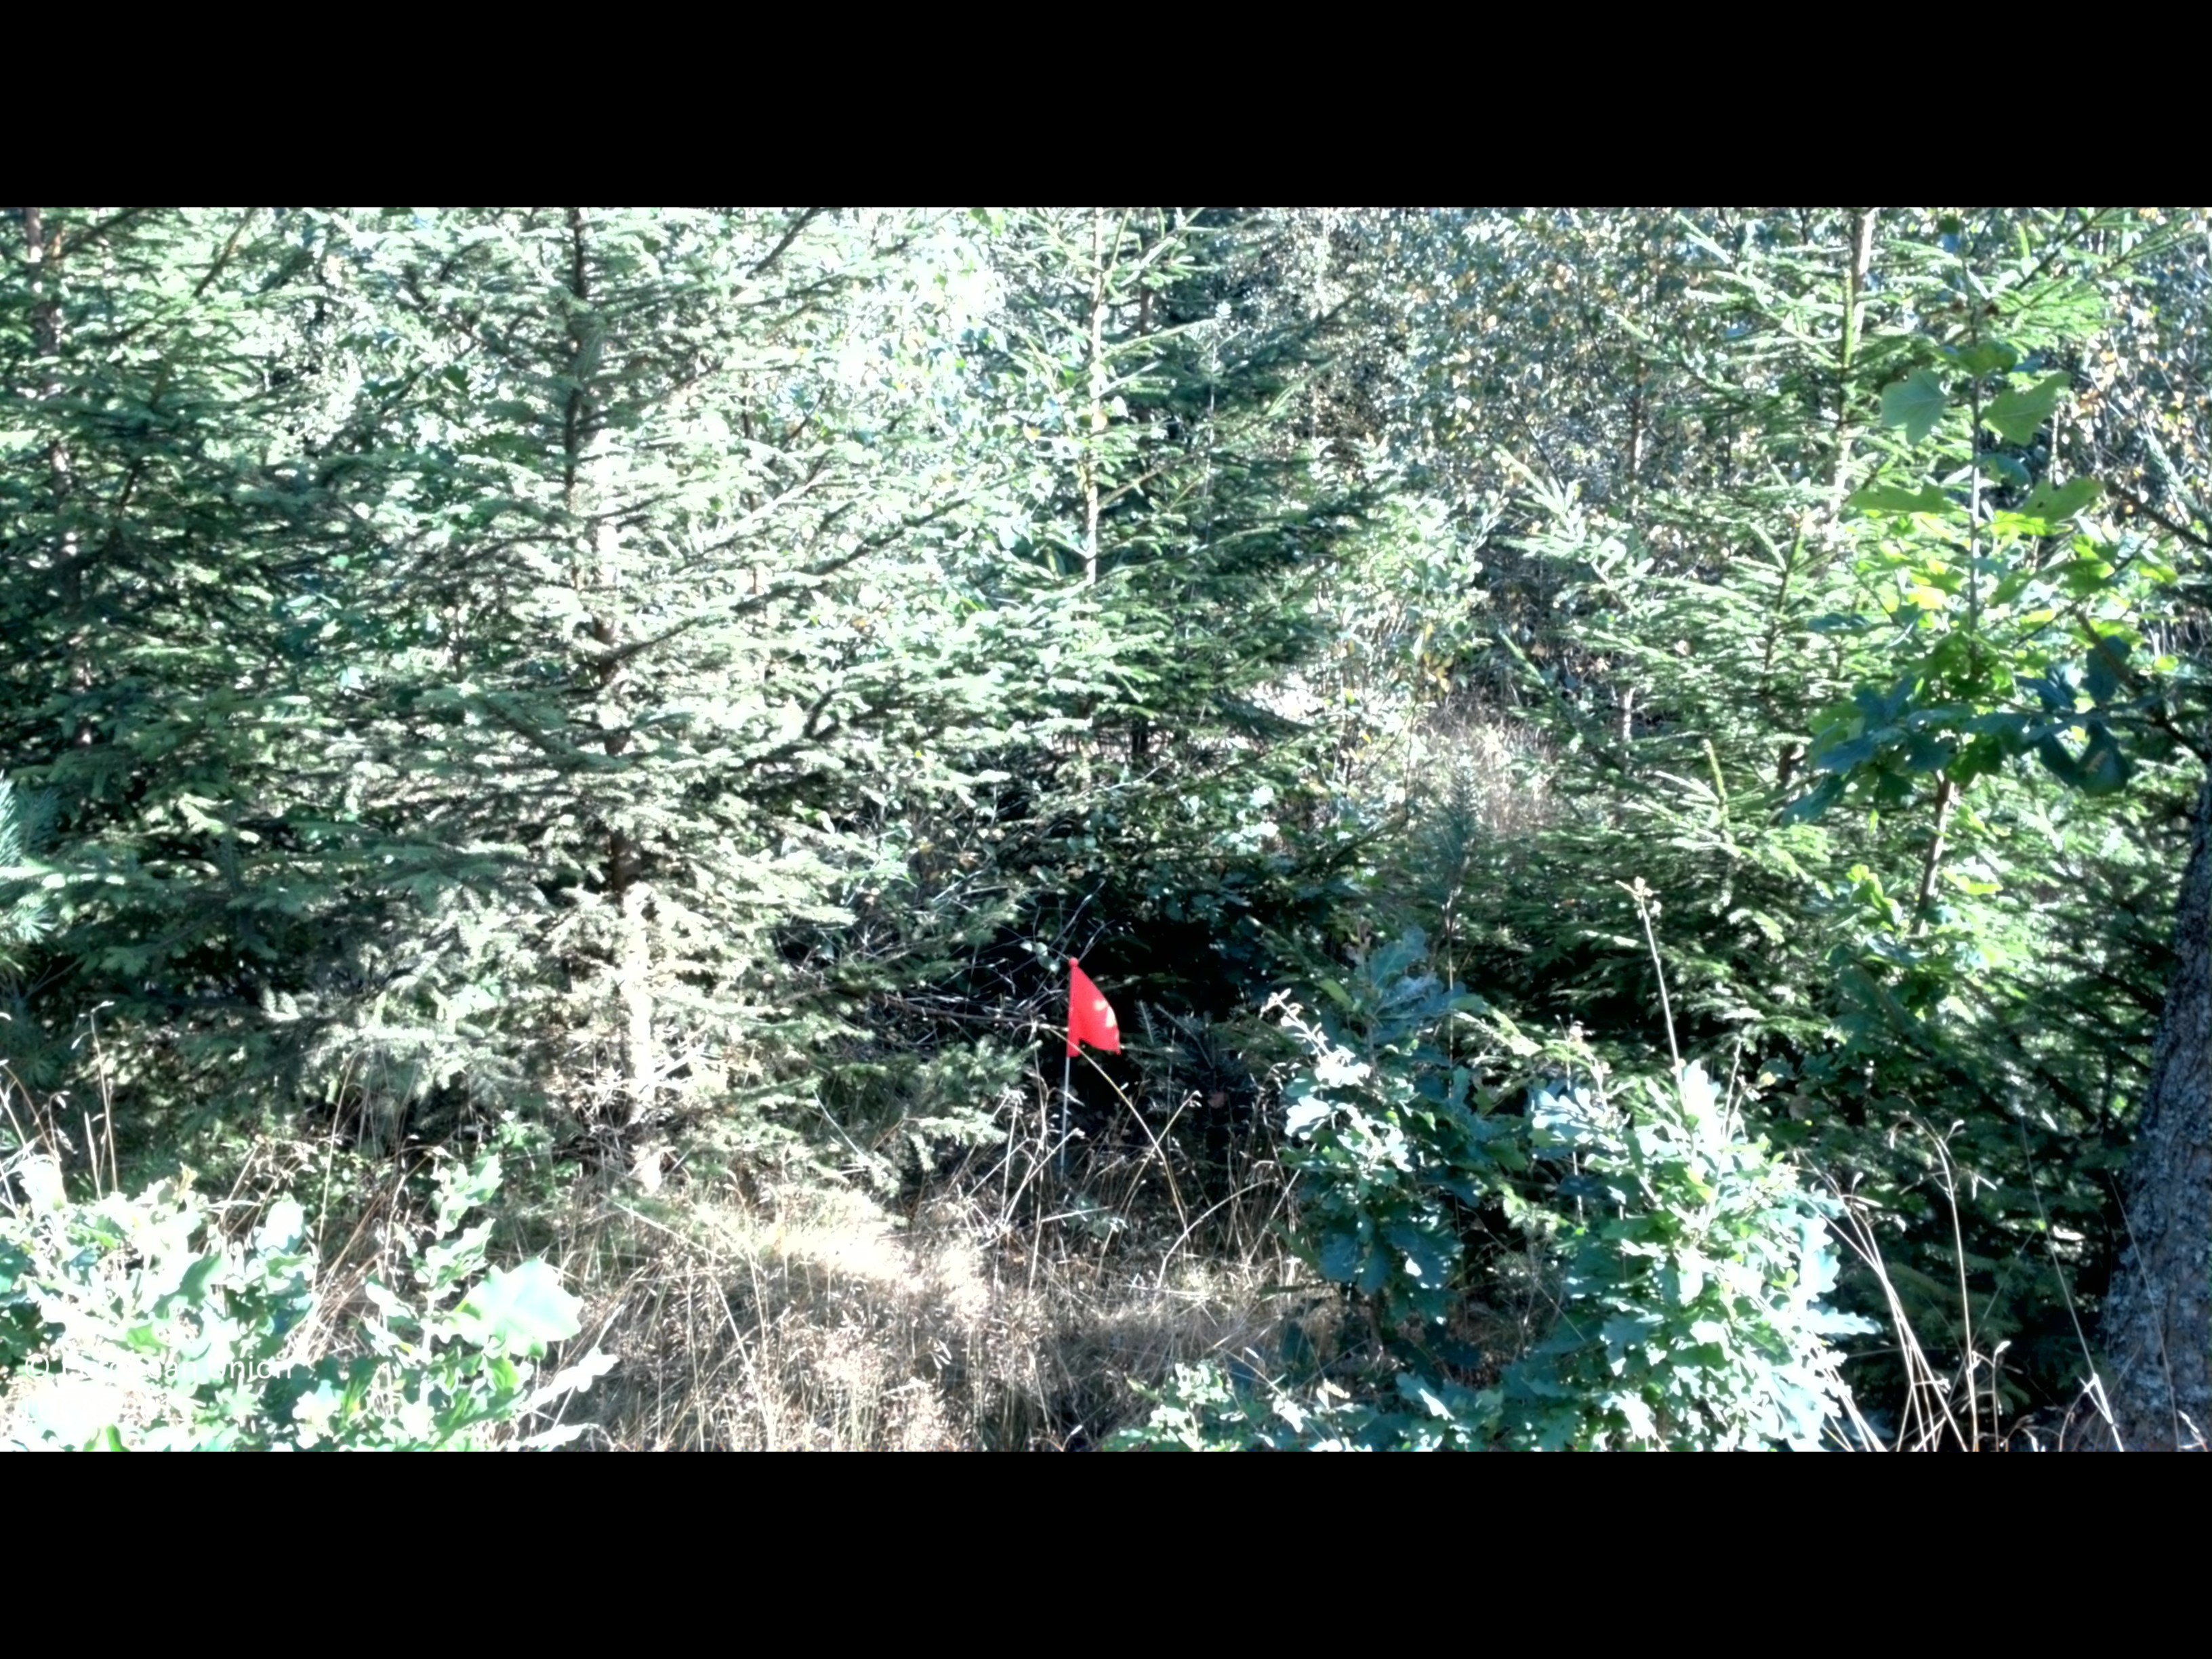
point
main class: Woodland
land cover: Spruce dominated mixed woodland
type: boreal forest
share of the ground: 50 - 75 %
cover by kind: broadleaved forest trees 40 %, herbaceous plants 30 %, coniferous forest trees 20 %, shrubs 10 %
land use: Forestry
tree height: < 5 m
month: August
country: SE
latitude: 57.0654
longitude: 13.8718
